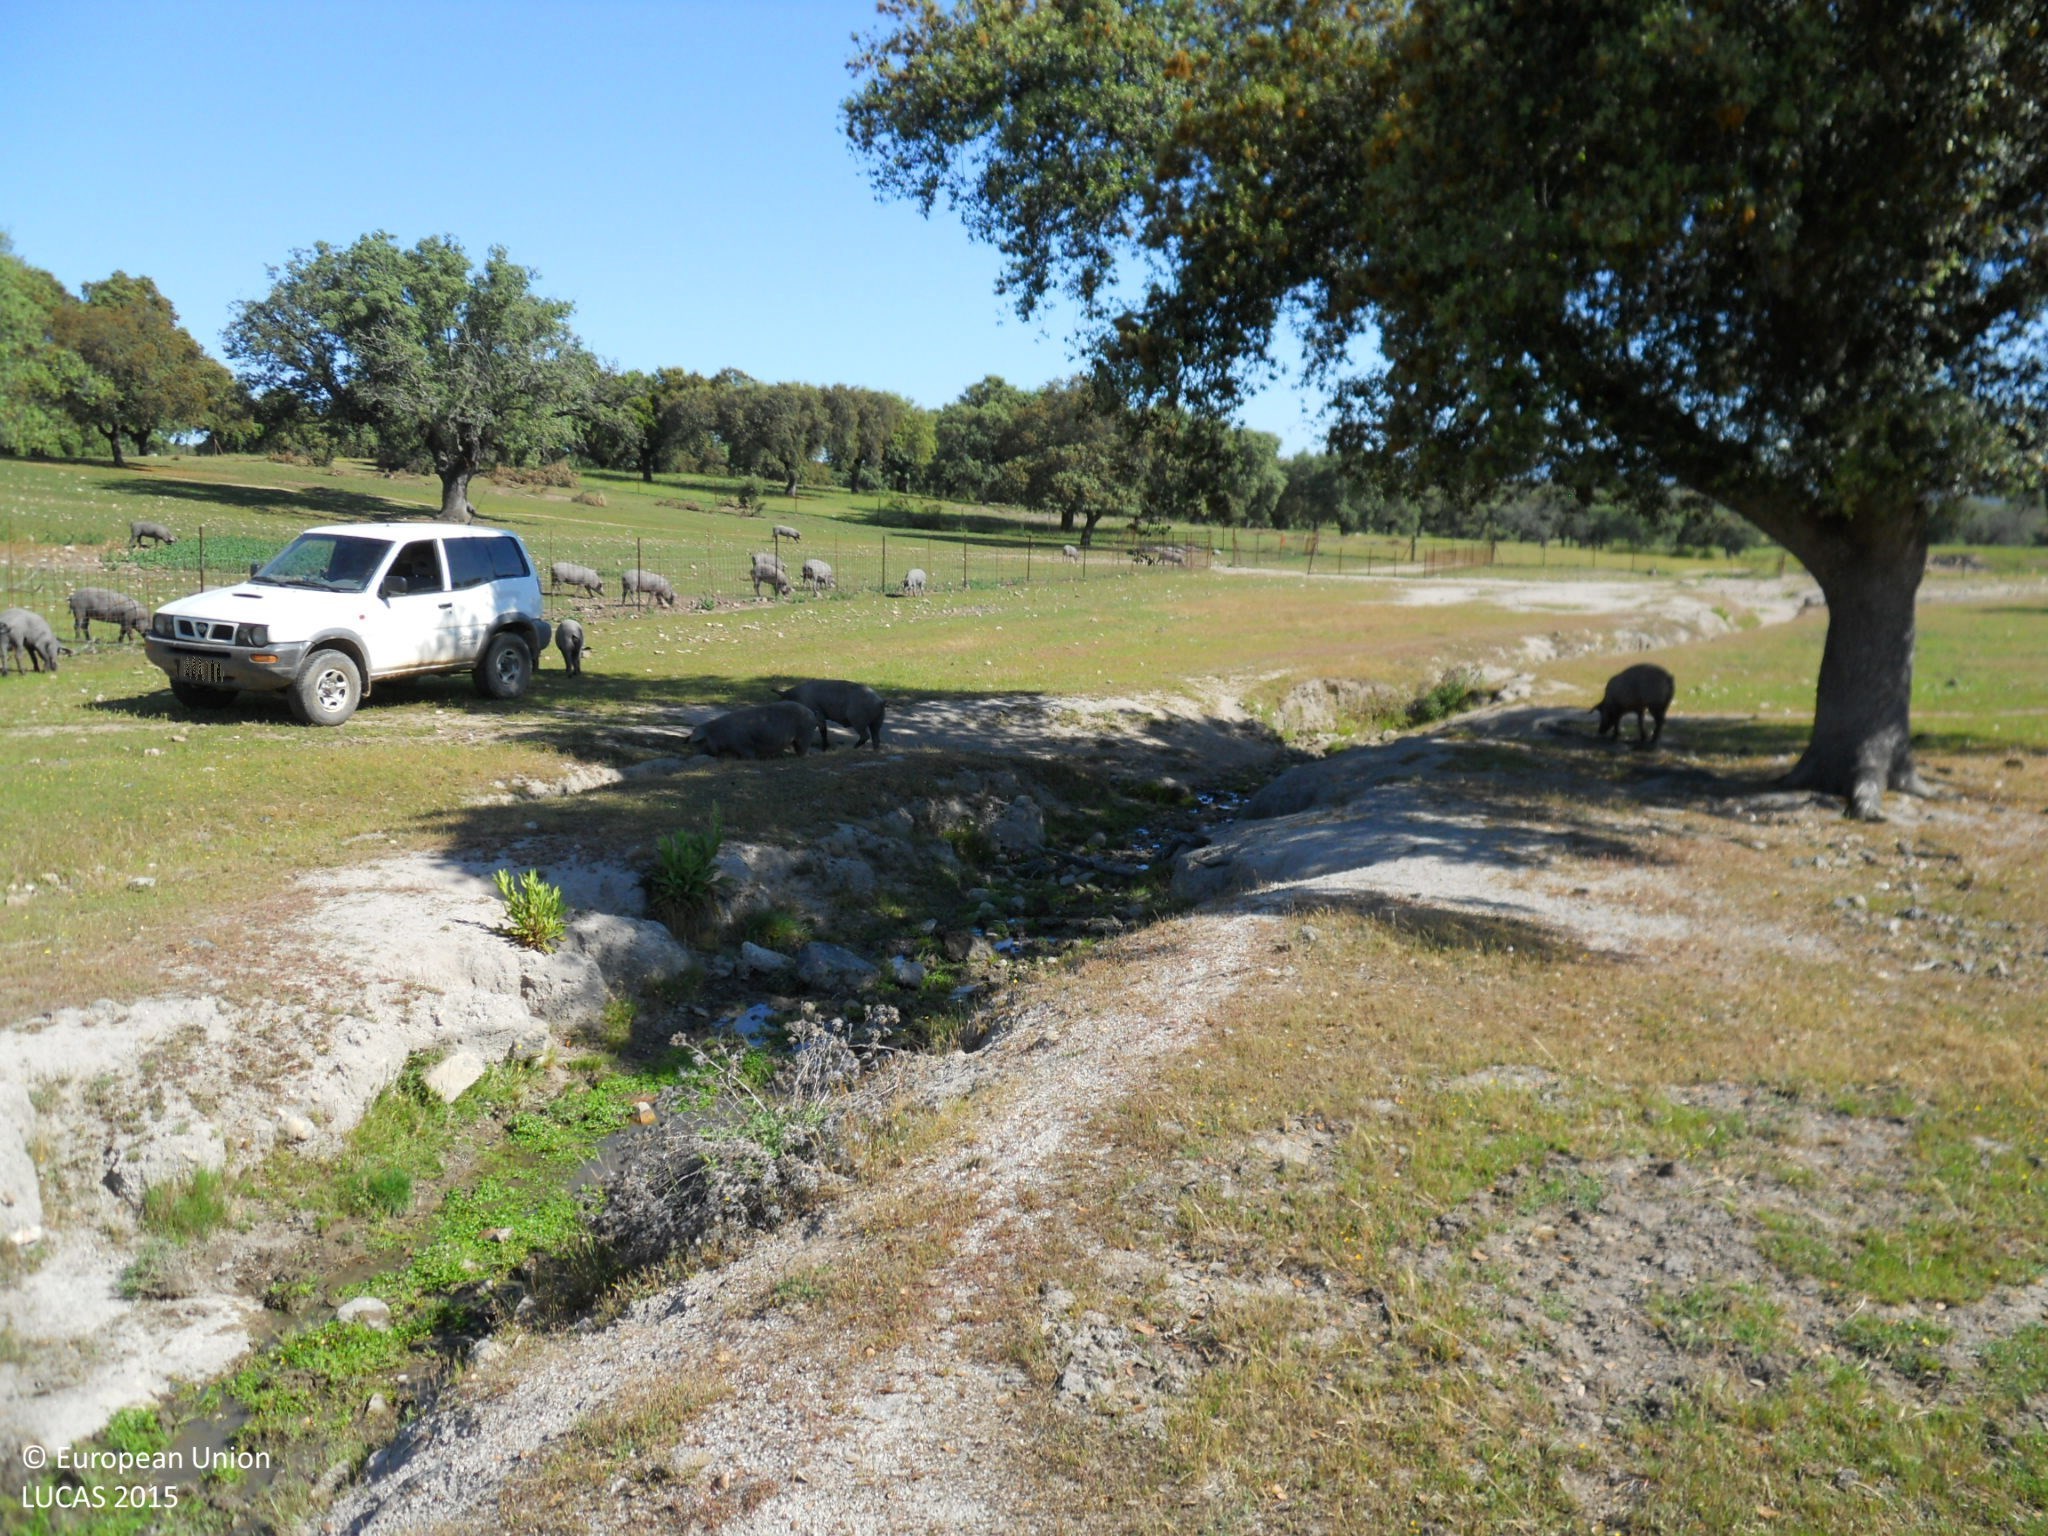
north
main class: Grassland
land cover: Grassland with sparse tree/shrub cover
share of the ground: > 75 %
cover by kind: herbaceous plants 70 %, unconsolidated bare surface 20 %, broadleaved forest trees 5 %, shrubs 5 %
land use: Agriculture (excluding fallow land and kitchen gardens)
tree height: > 5 m
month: April
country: ES
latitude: 39.3202
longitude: -7.0254
